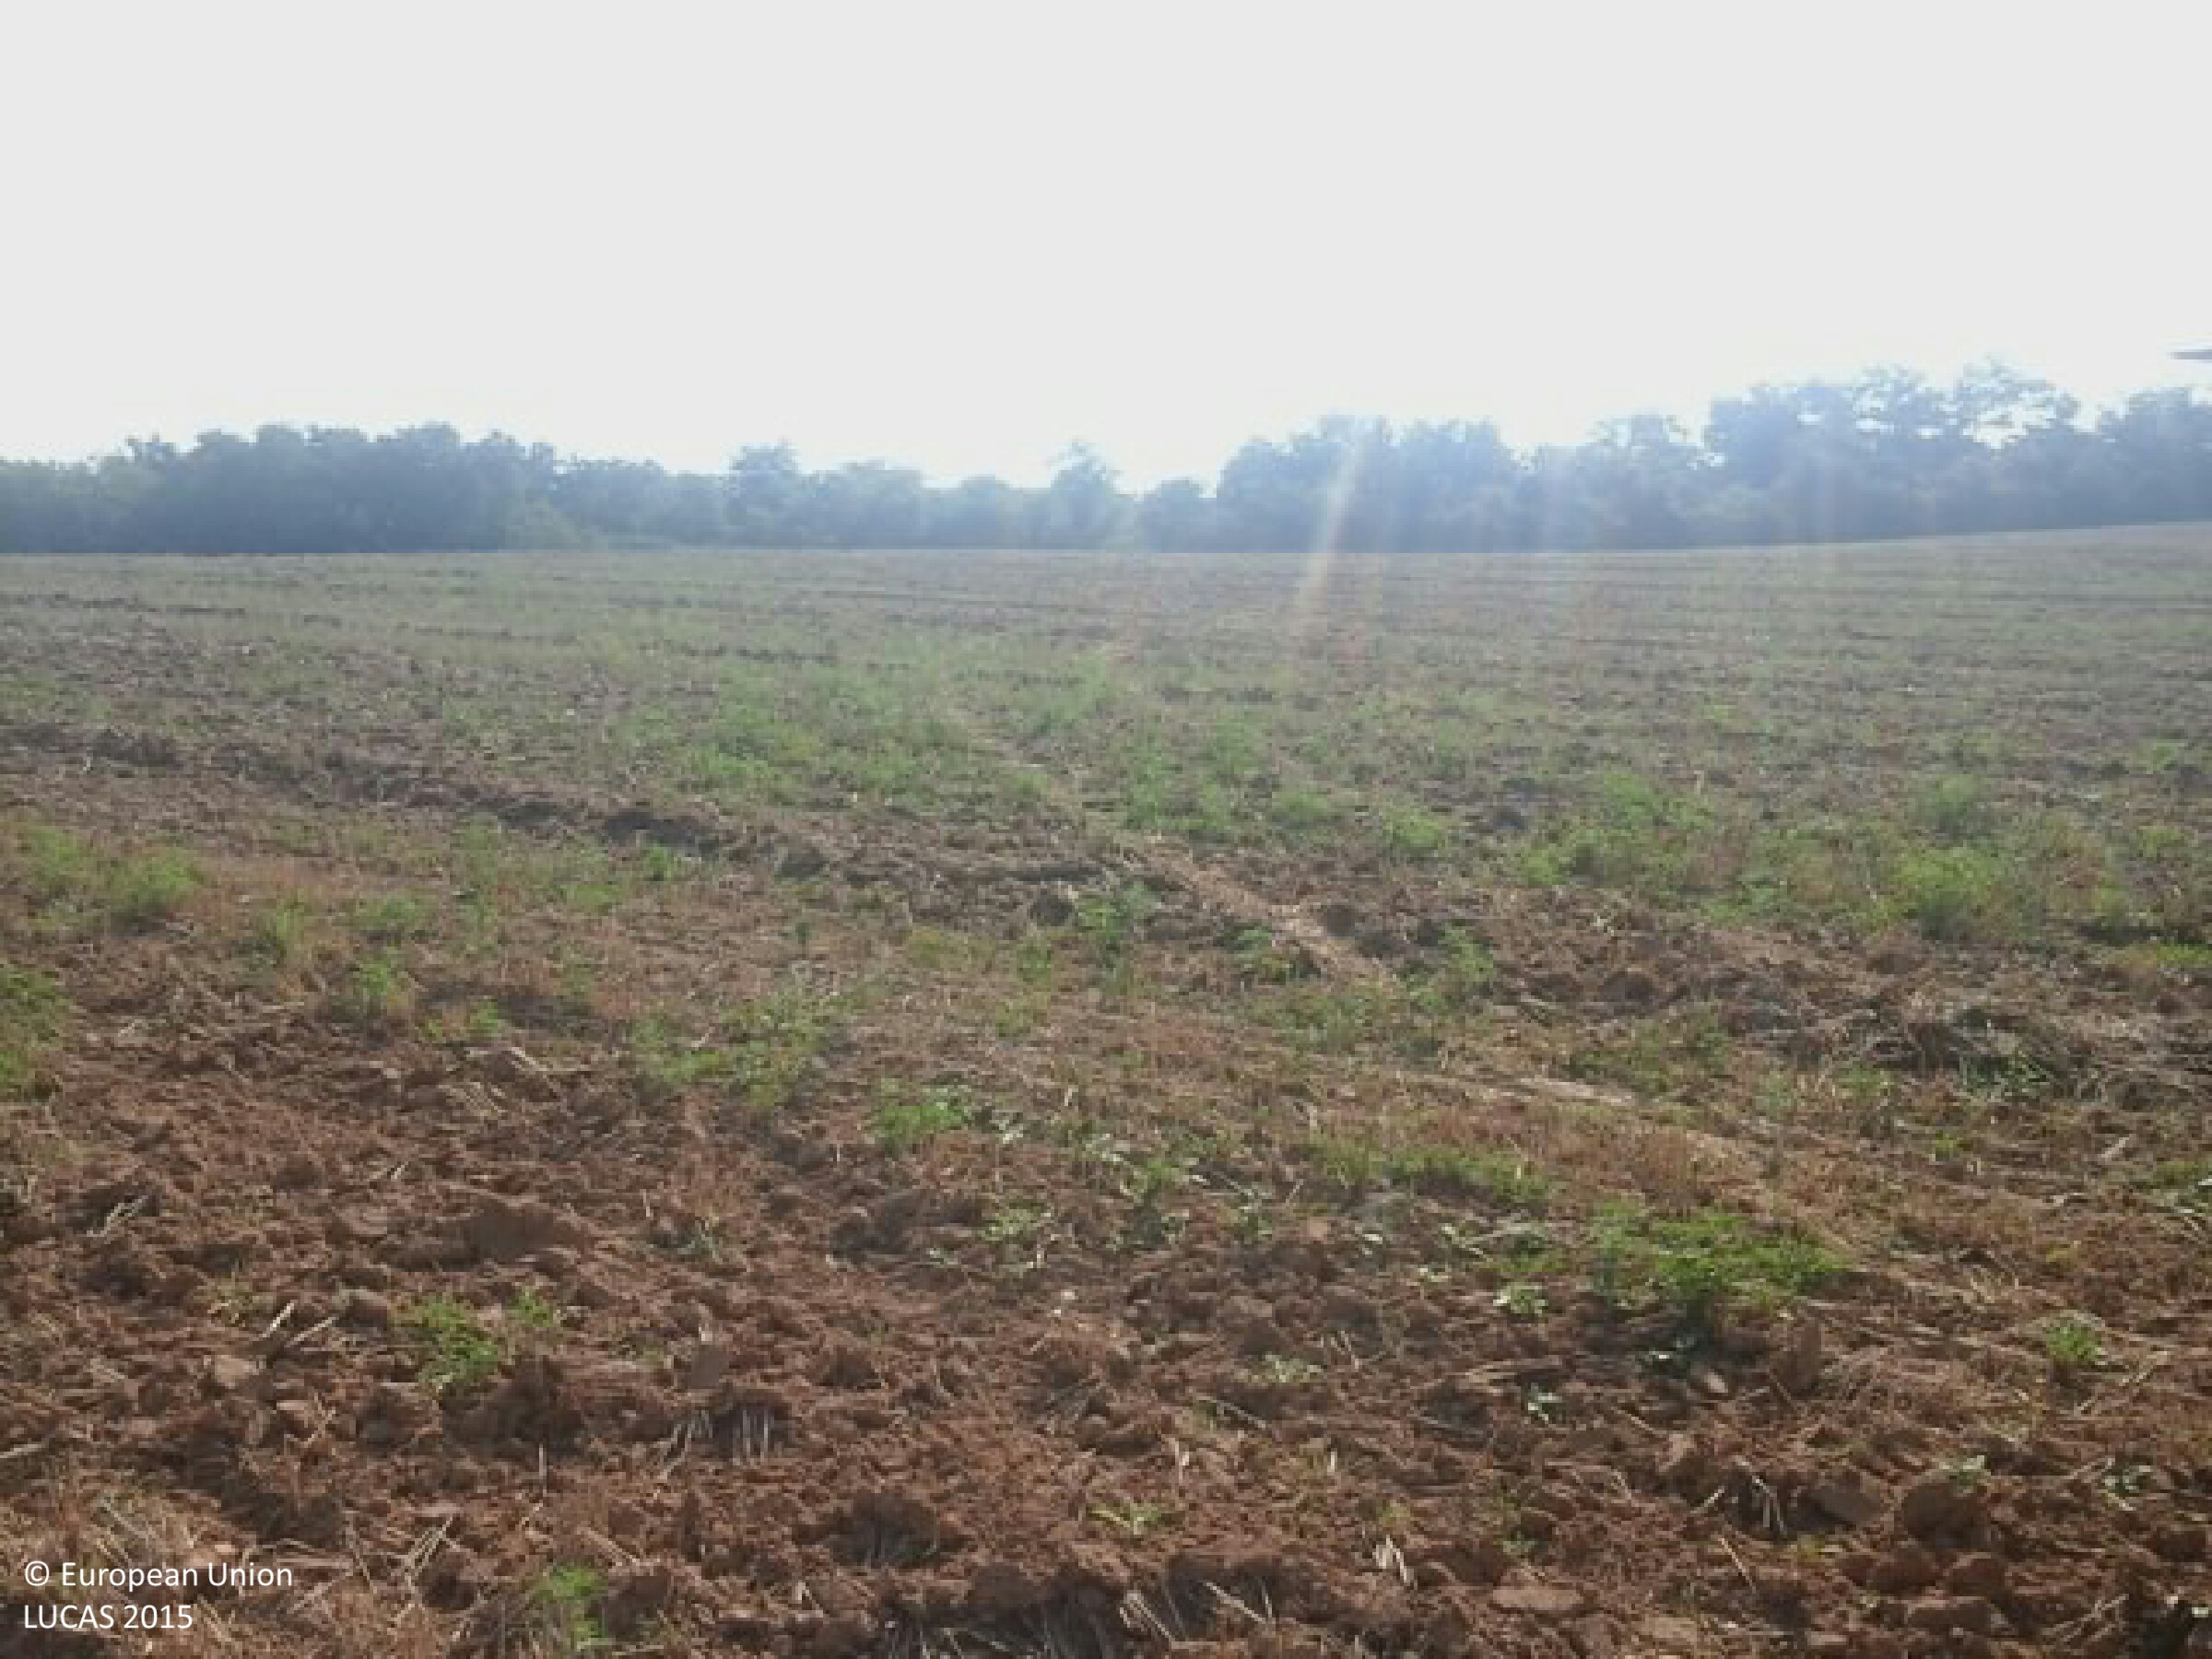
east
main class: Cropland
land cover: Triticale
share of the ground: < 10 %
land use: Agriculture (excluding fallow land and kitchen gardens)
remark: Harvested field
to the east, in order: Triticale; Broadleaved woodland; Electric lines; Broadleaved woodland
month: August
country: HU
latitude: 46.3611
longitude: 18.2093
